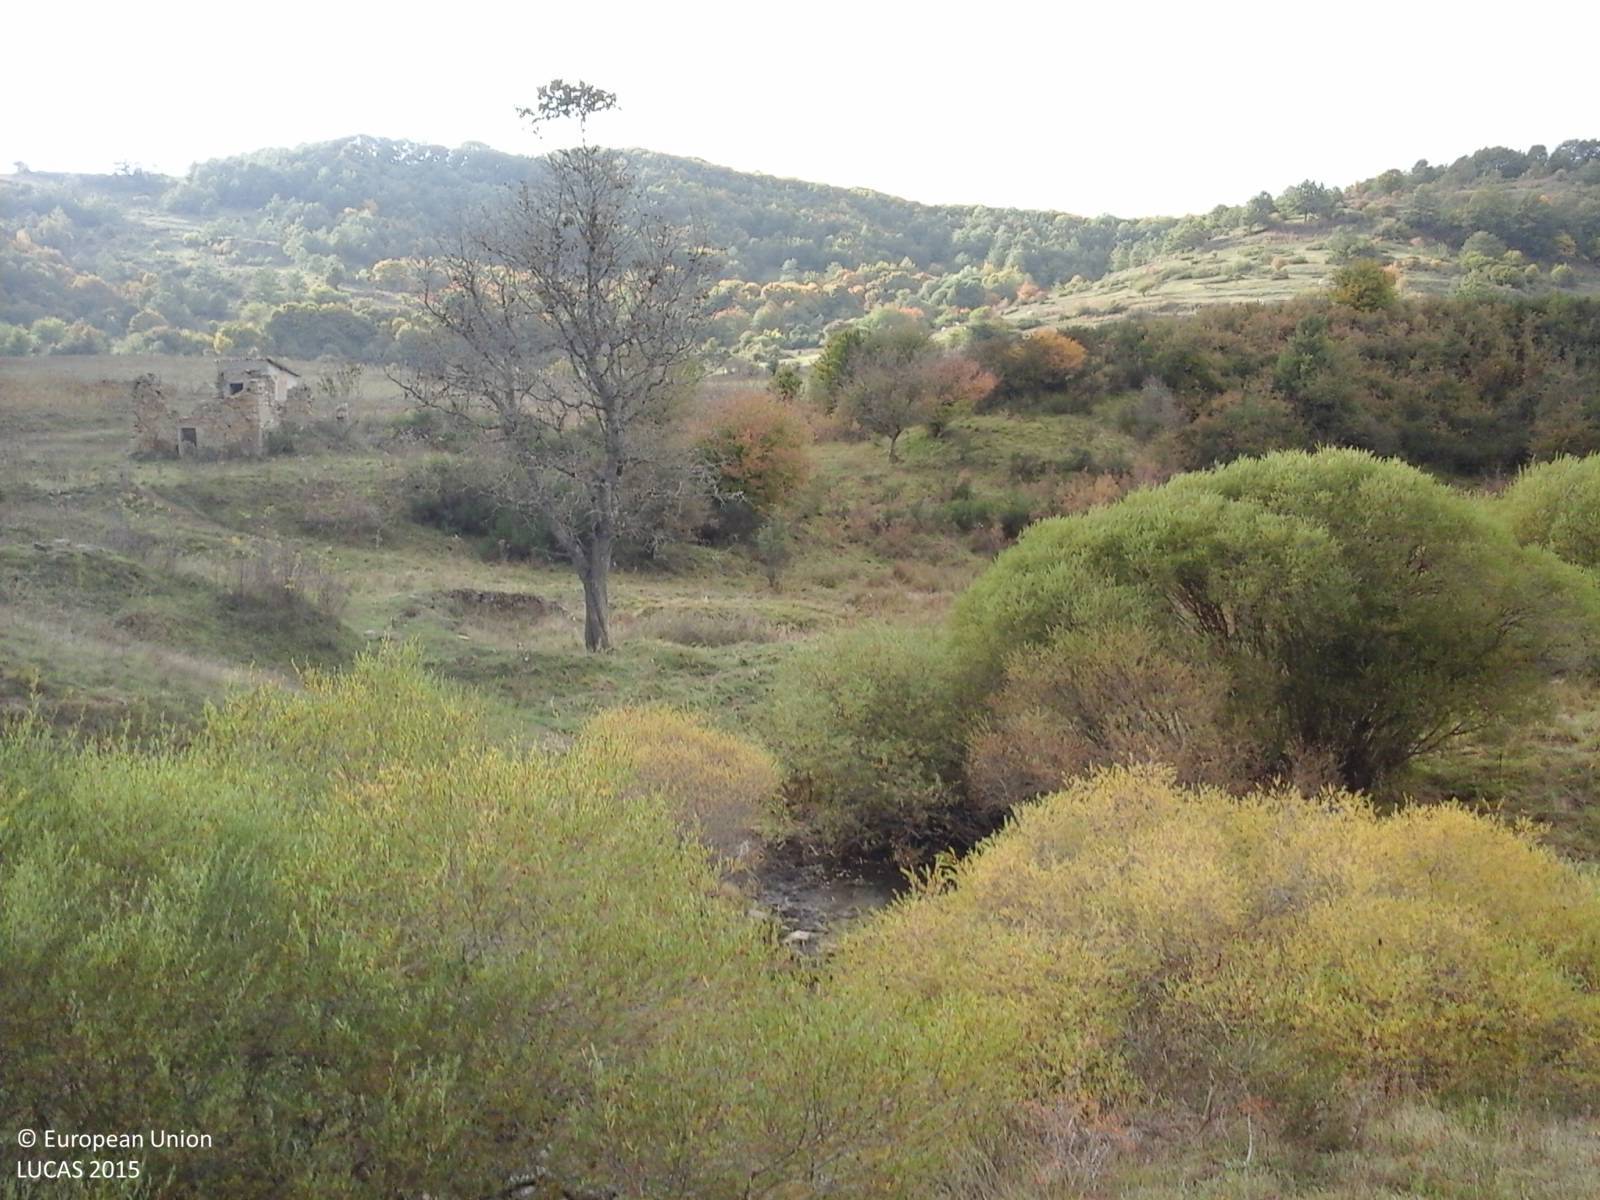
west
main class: Grassland
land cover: Grassland without tree/shrub cover
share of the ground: > 75 %
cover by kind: herbaceous plants 100 %
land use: Agriculture (excluding fallow land and kitchen gardens)
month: October
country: IT
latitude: 42.5817
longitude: 13.3161
